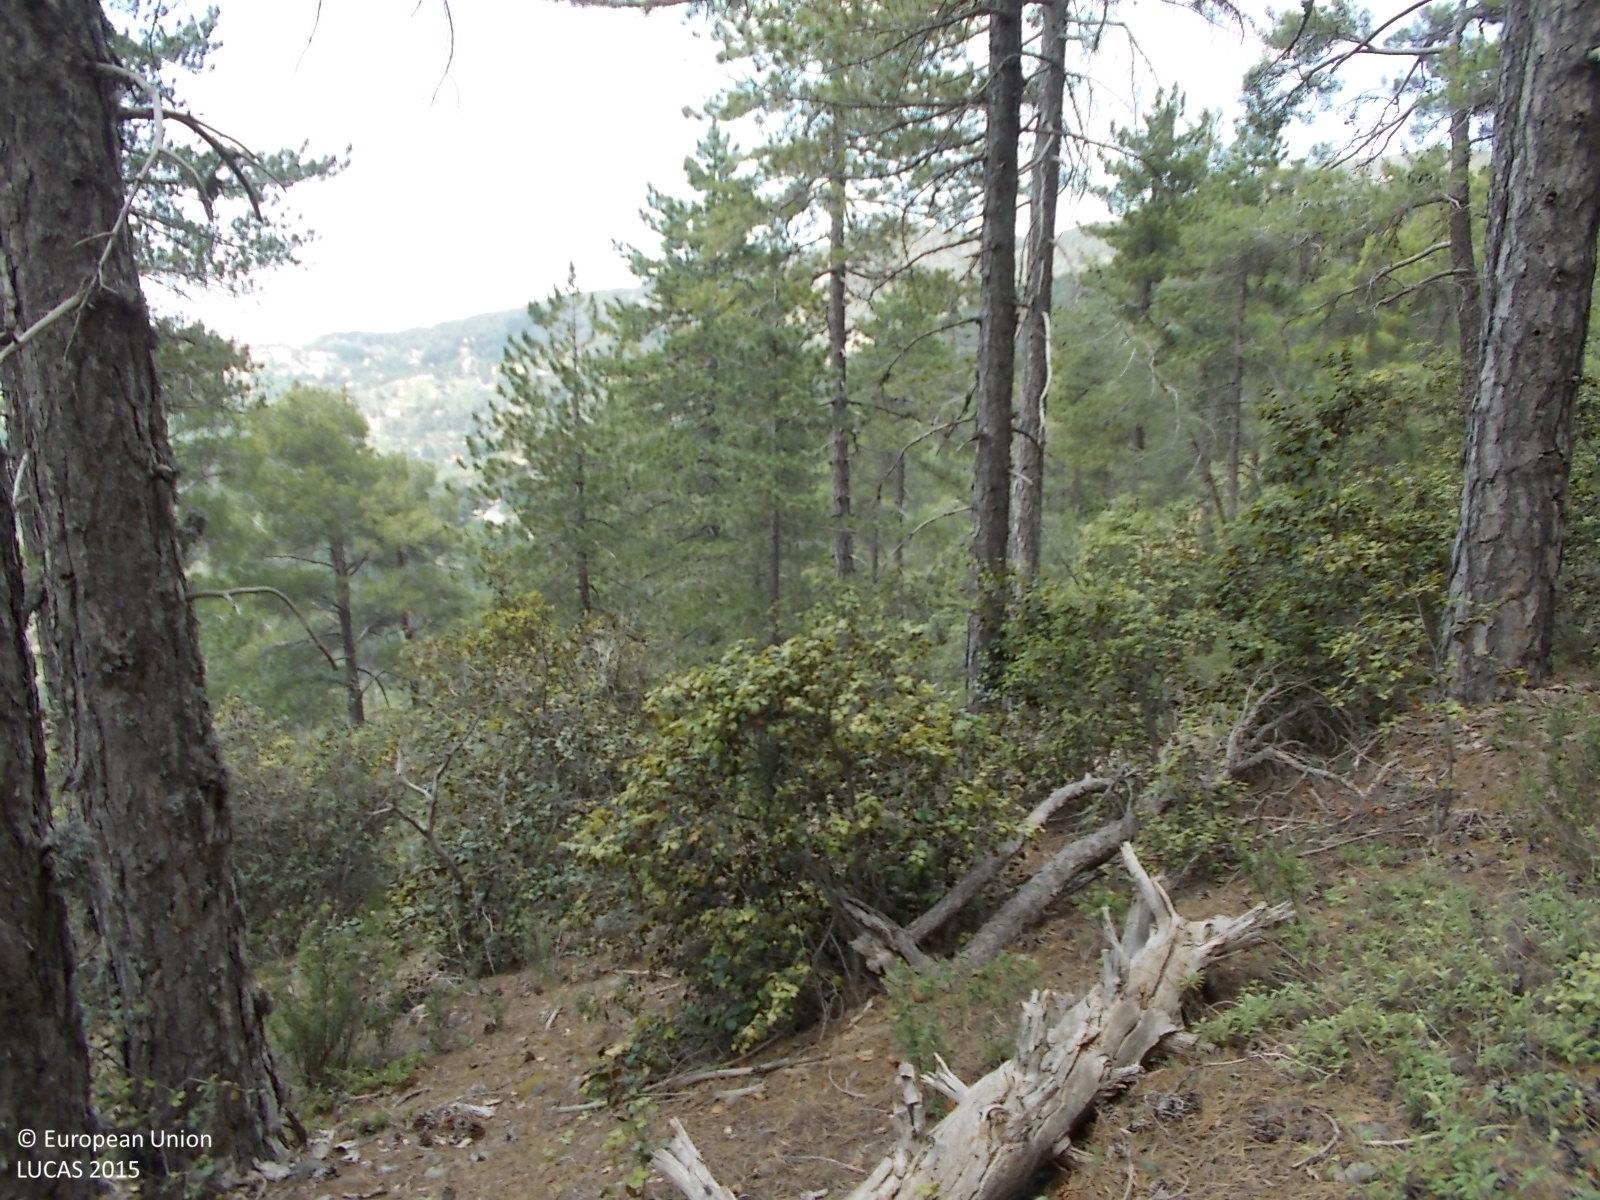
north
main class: Woodland
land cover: Pine dominated mixed woodland
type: coniferous forest of the mediterranean region
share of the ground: > 75 %
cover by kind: coniferous forest trees 70 %, broadleaved forest trees 25 %, shrubs 5 %
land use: Forestry
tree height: > 5 m
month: June
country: CY
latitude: 34.9292
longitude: 32.8372
